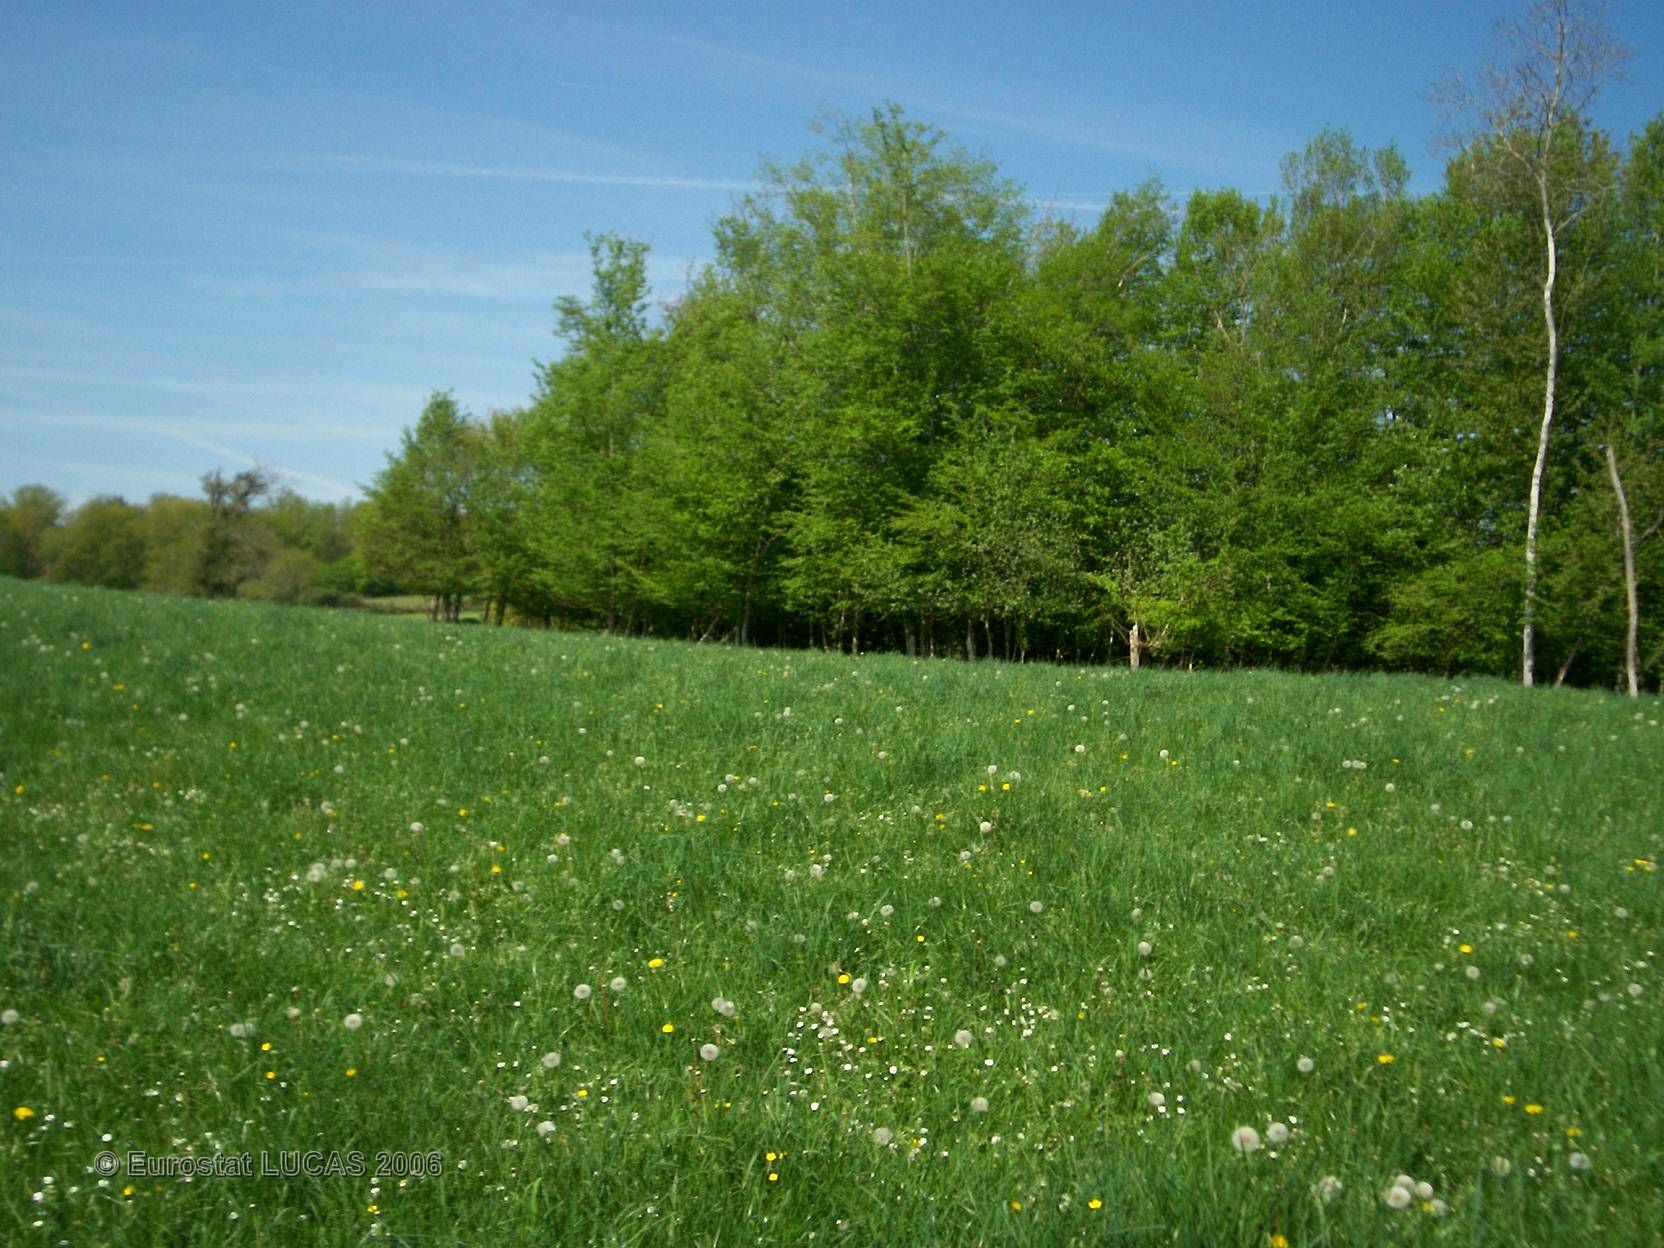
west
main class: Grassland
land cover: Grassland without tree/shrub cover
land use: Agriculture (excluding fallow land and kitchen gardens)
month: May
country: FR
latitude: 46.3848
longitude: 1.6301
